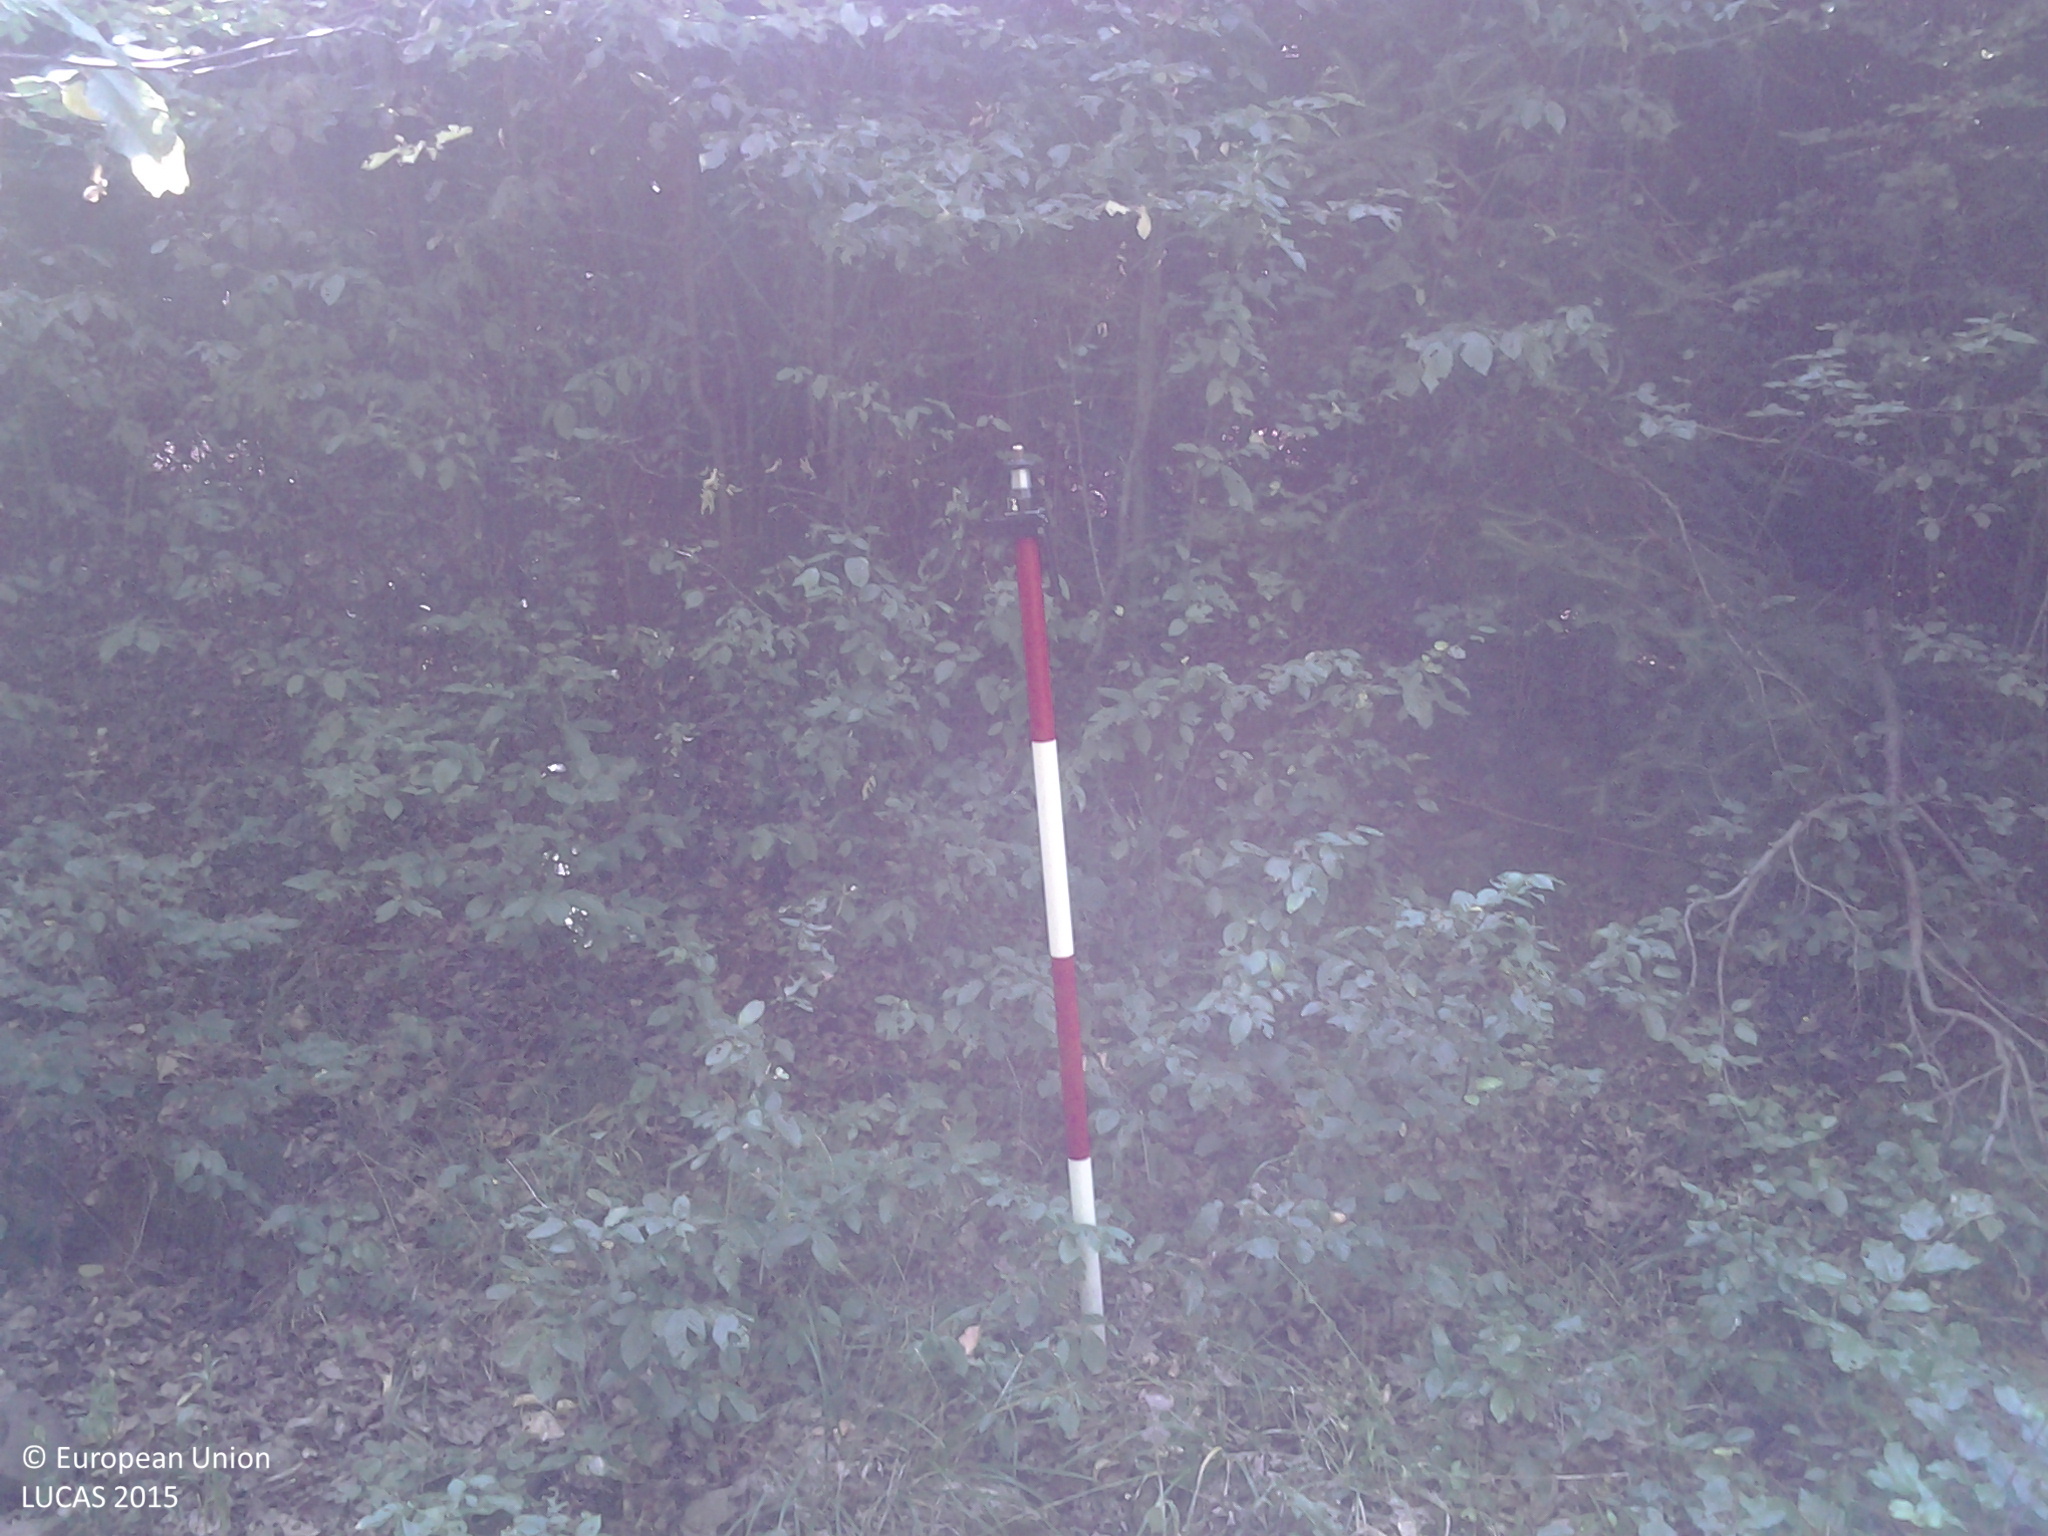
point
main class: Woodland
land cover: Broadleaved woodland
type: beech forest
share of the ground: > 75 %
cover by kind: broadleaved forest trees 85 %, shrubs 15 %
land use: Forestry
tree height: > 5 m
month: August
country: HU
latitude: 47.9382
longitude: 19.9197
